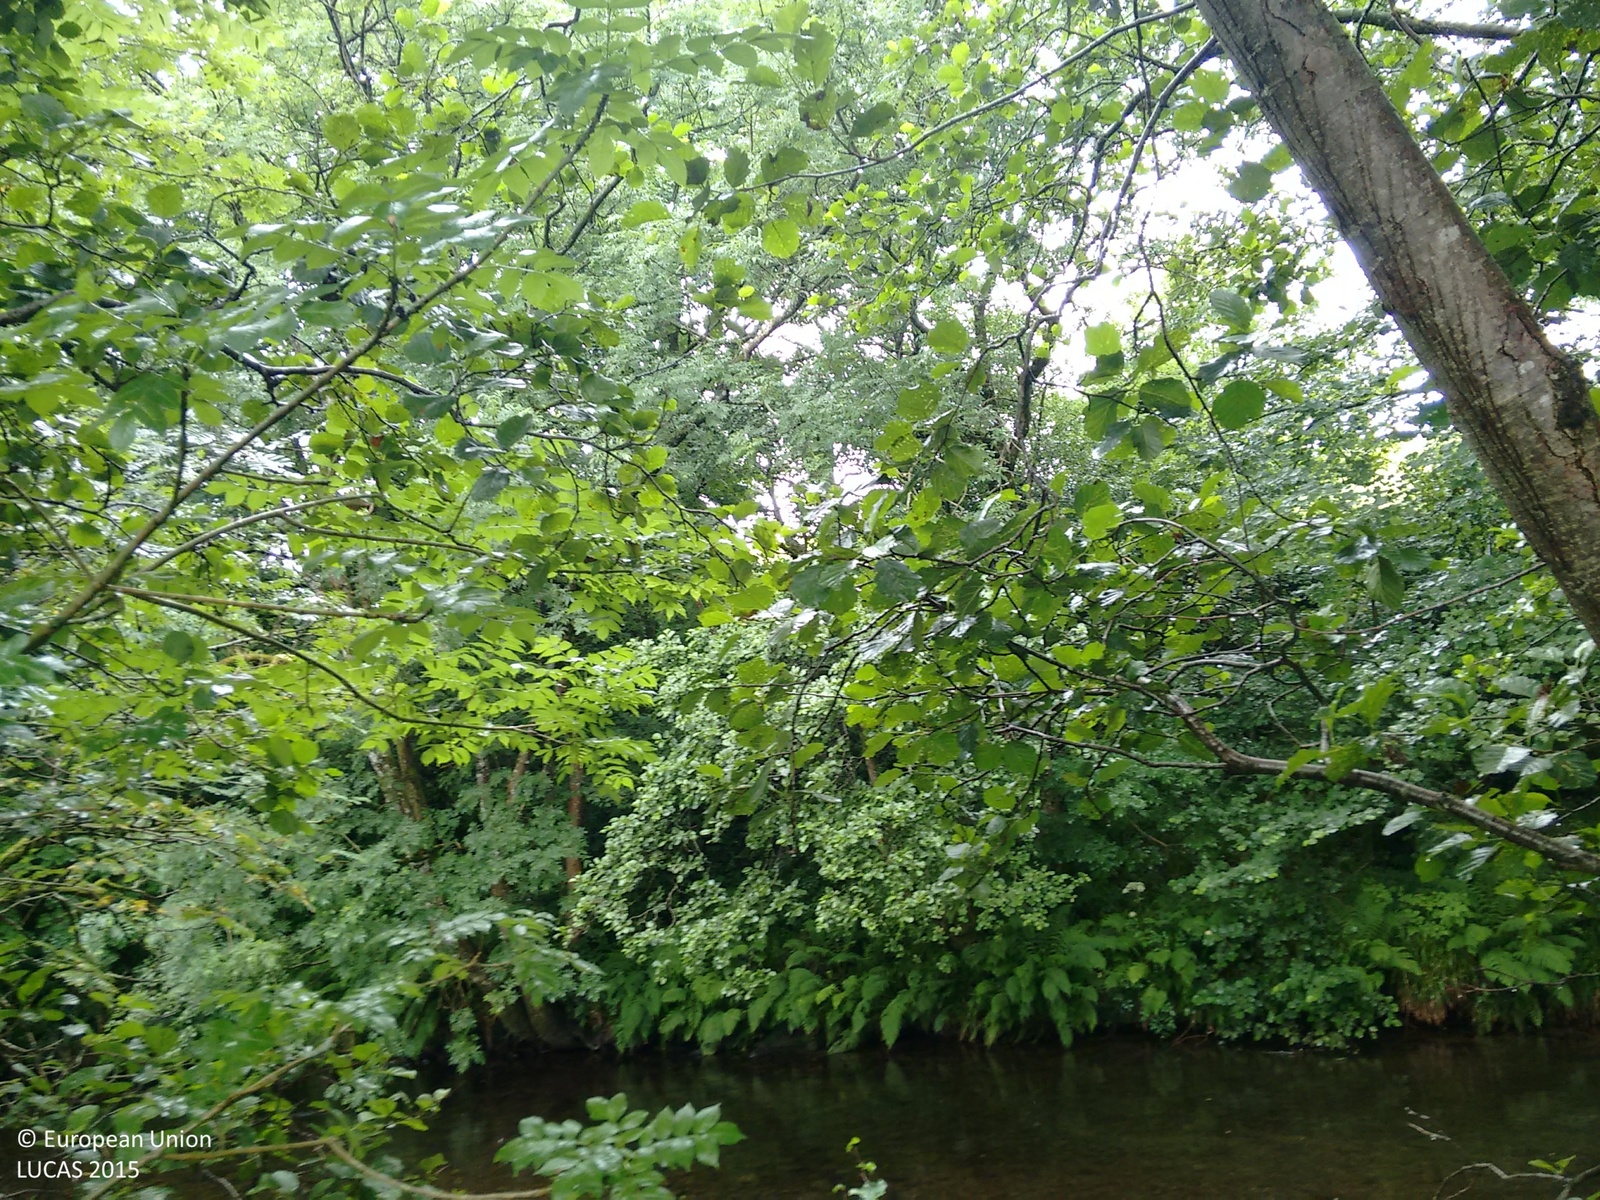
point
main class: Woodland
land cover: Broadleaved woodland
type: floodplain forest
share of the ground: > 75 %
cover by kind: broadleaved forest trees 100 %
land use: Semi-natural and natural areas not in use
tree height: > 5 m
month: August
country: GB
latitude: 55.3138
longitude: -3.4238
